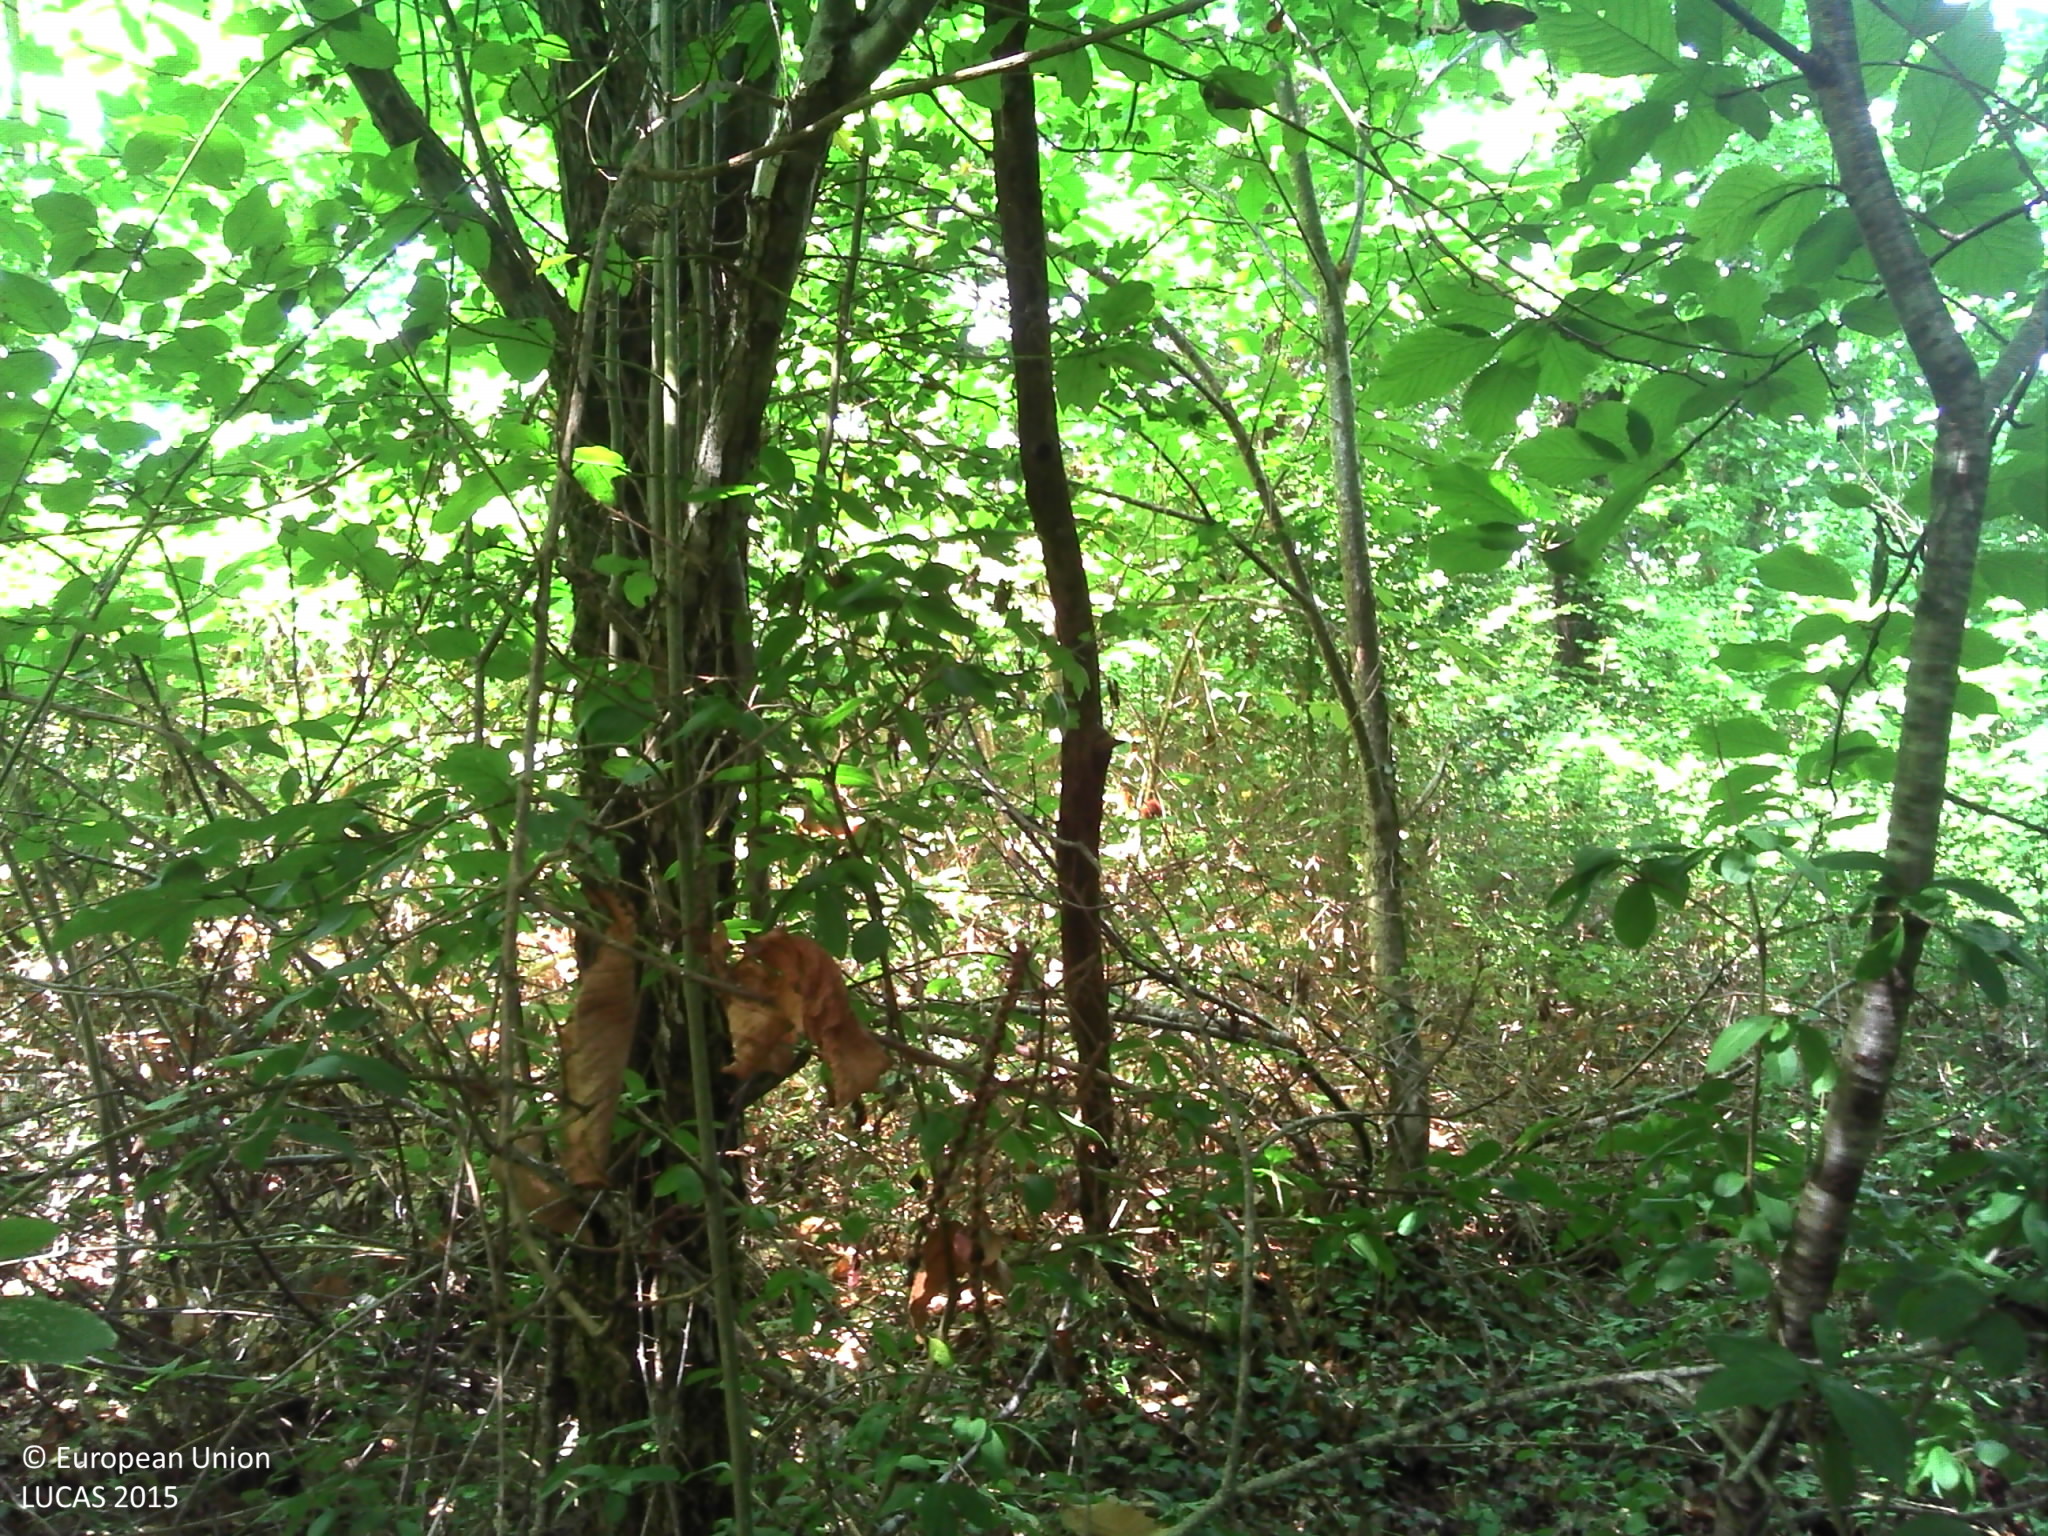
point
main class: Woodland
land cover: Broadleaved woodland
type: thermophilous deciduous forest
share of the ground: > 75 %
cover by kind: broadleaved forest trees 70 %, shrubs 20 %, herbaceous plants 5 %, lichens and mosses 5 %
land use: Forestry
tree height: > 5 m
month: August
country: FR
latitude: 45.3632
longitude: 0.4763
